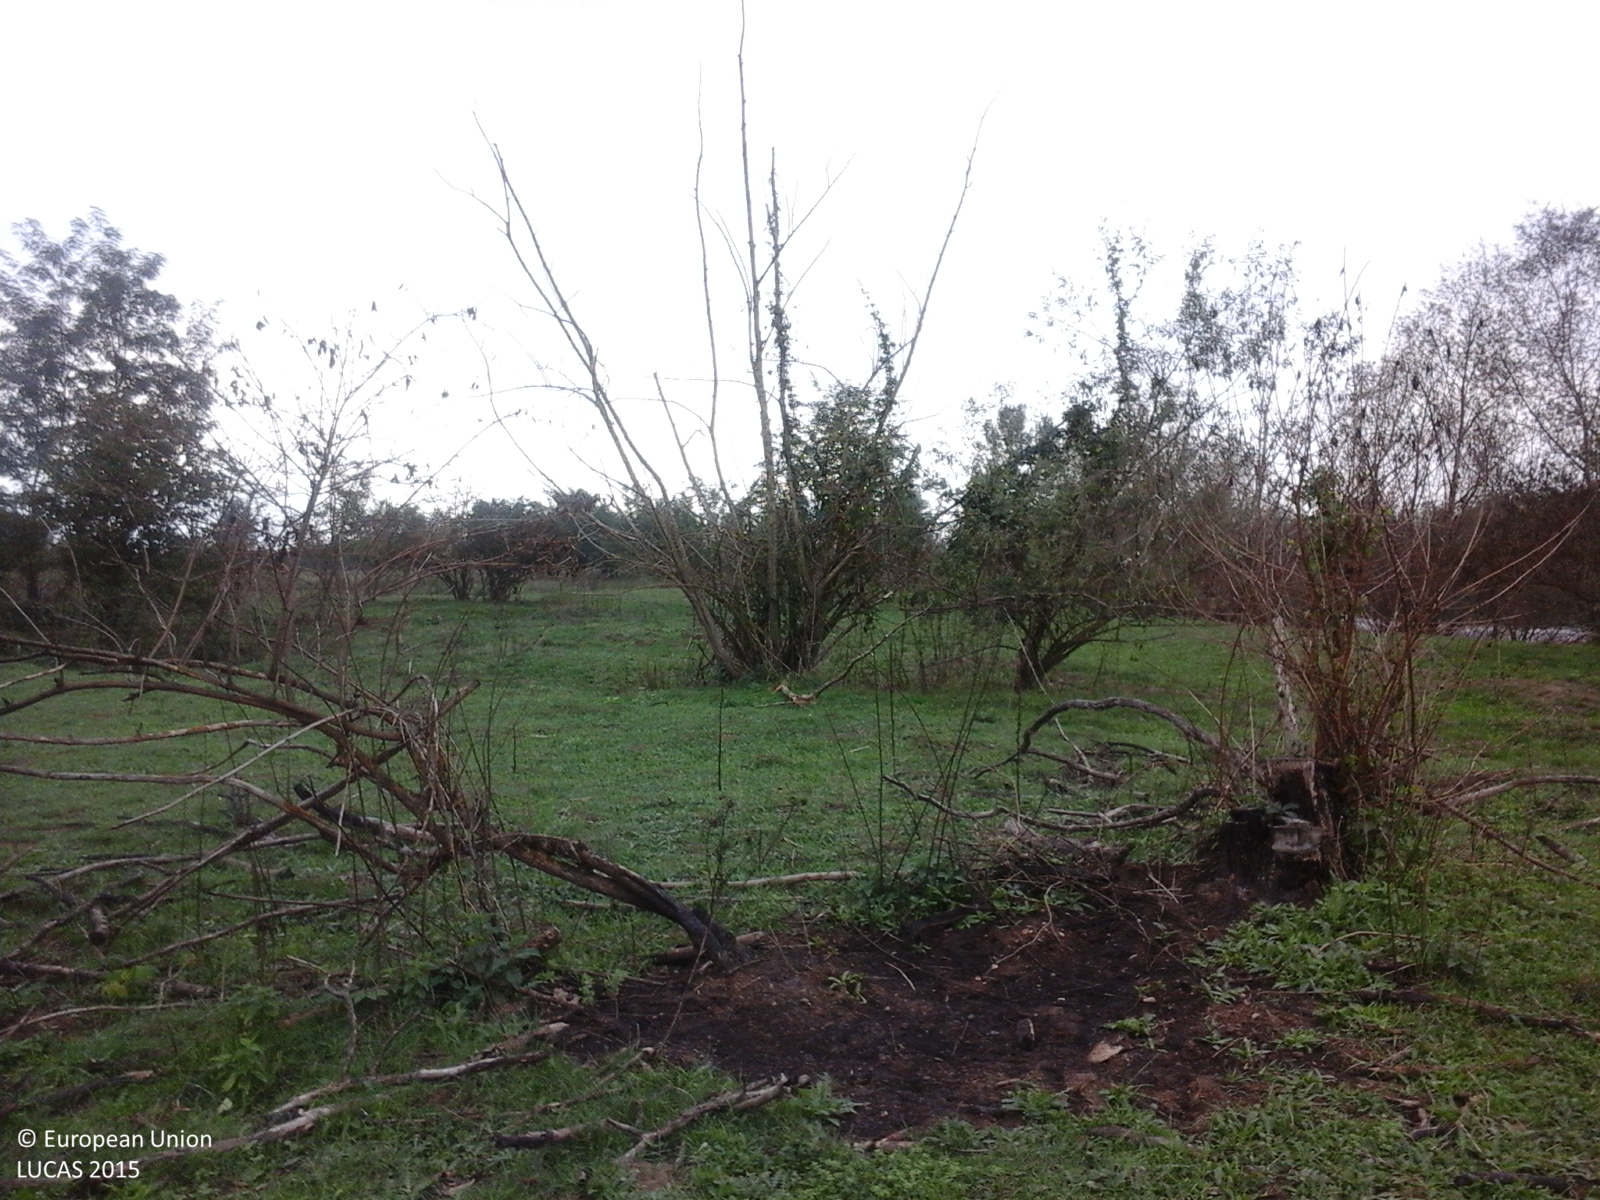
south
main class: Grassland
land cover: Grassland without tree/shrub cover
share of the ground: > 75 %
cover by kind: herbaceous plants 100 %
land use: Agriculture (excluding fallow land and kitchen gardens)
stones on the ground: < 10 %
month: September
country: RO
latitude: 45.6326
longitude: 22.0338
